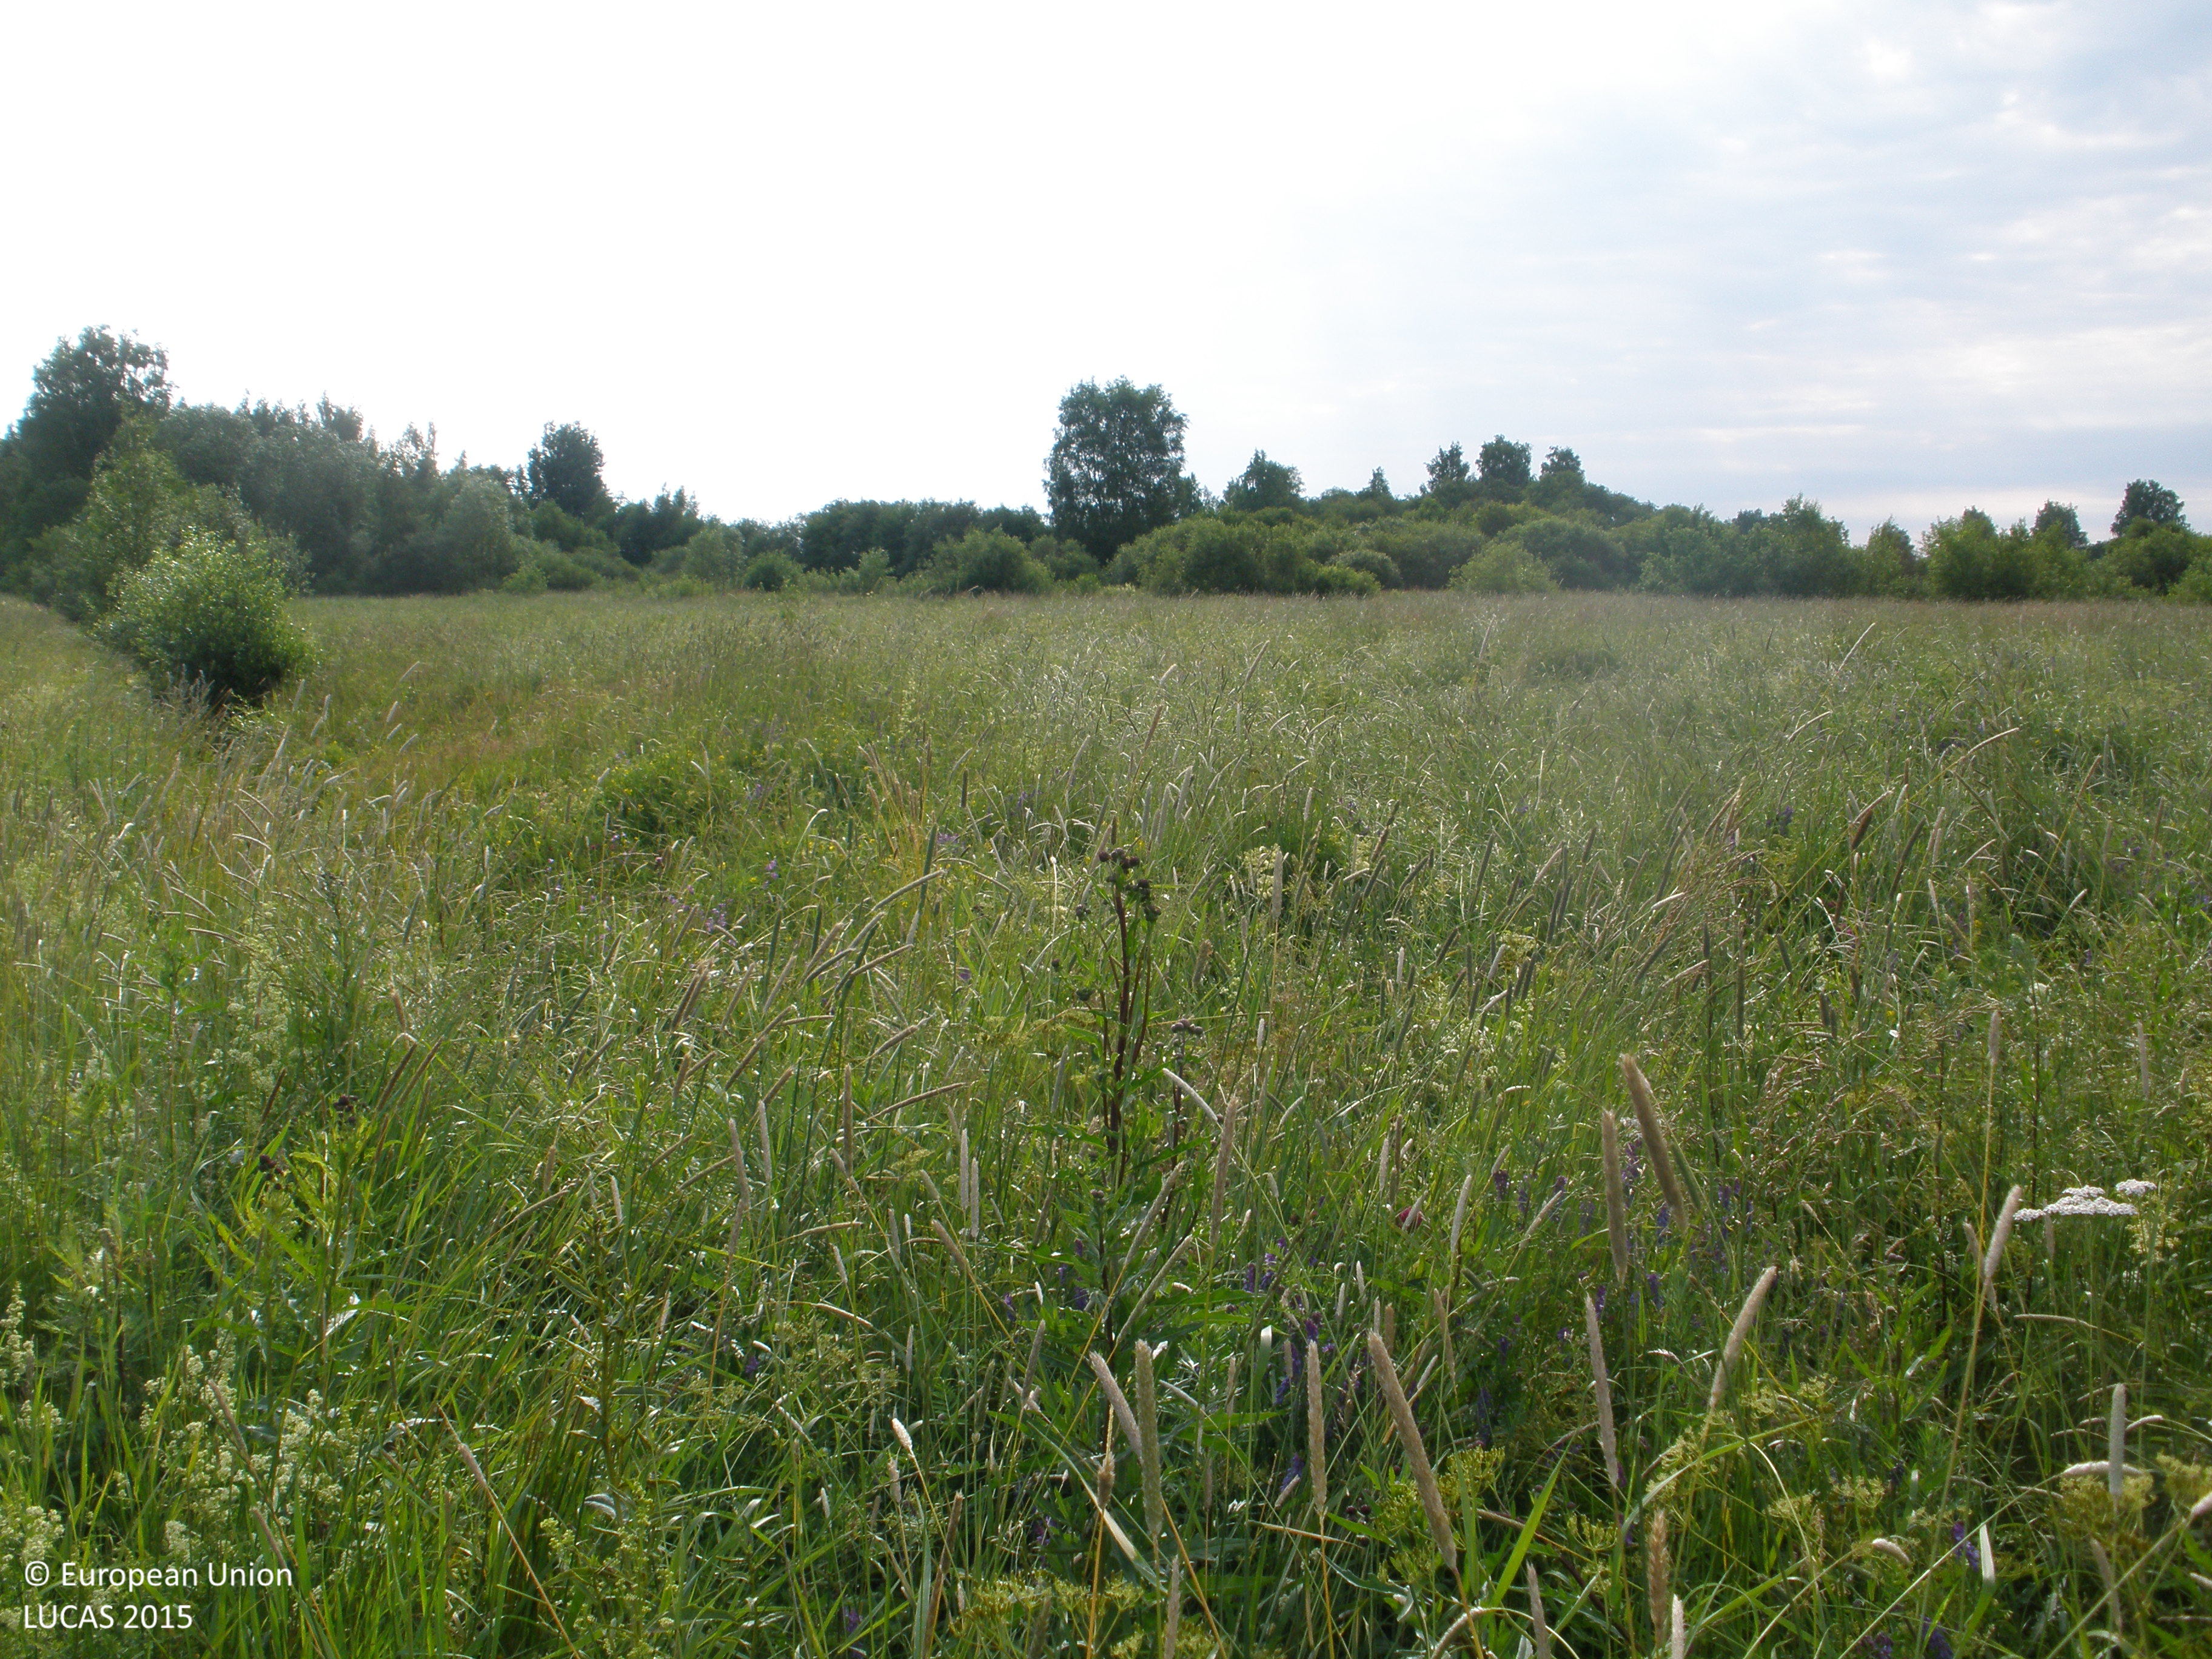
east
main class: Cropland
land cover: Common wheat
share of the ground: 50 - 75 %
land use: Agriculture (excluding fallow land and kitchen gardens)
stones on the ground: < 10 %
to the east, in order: Common wheat; Electric lines; Common wheat
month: July
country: FI
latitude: 61.3075
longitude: 23.6579
